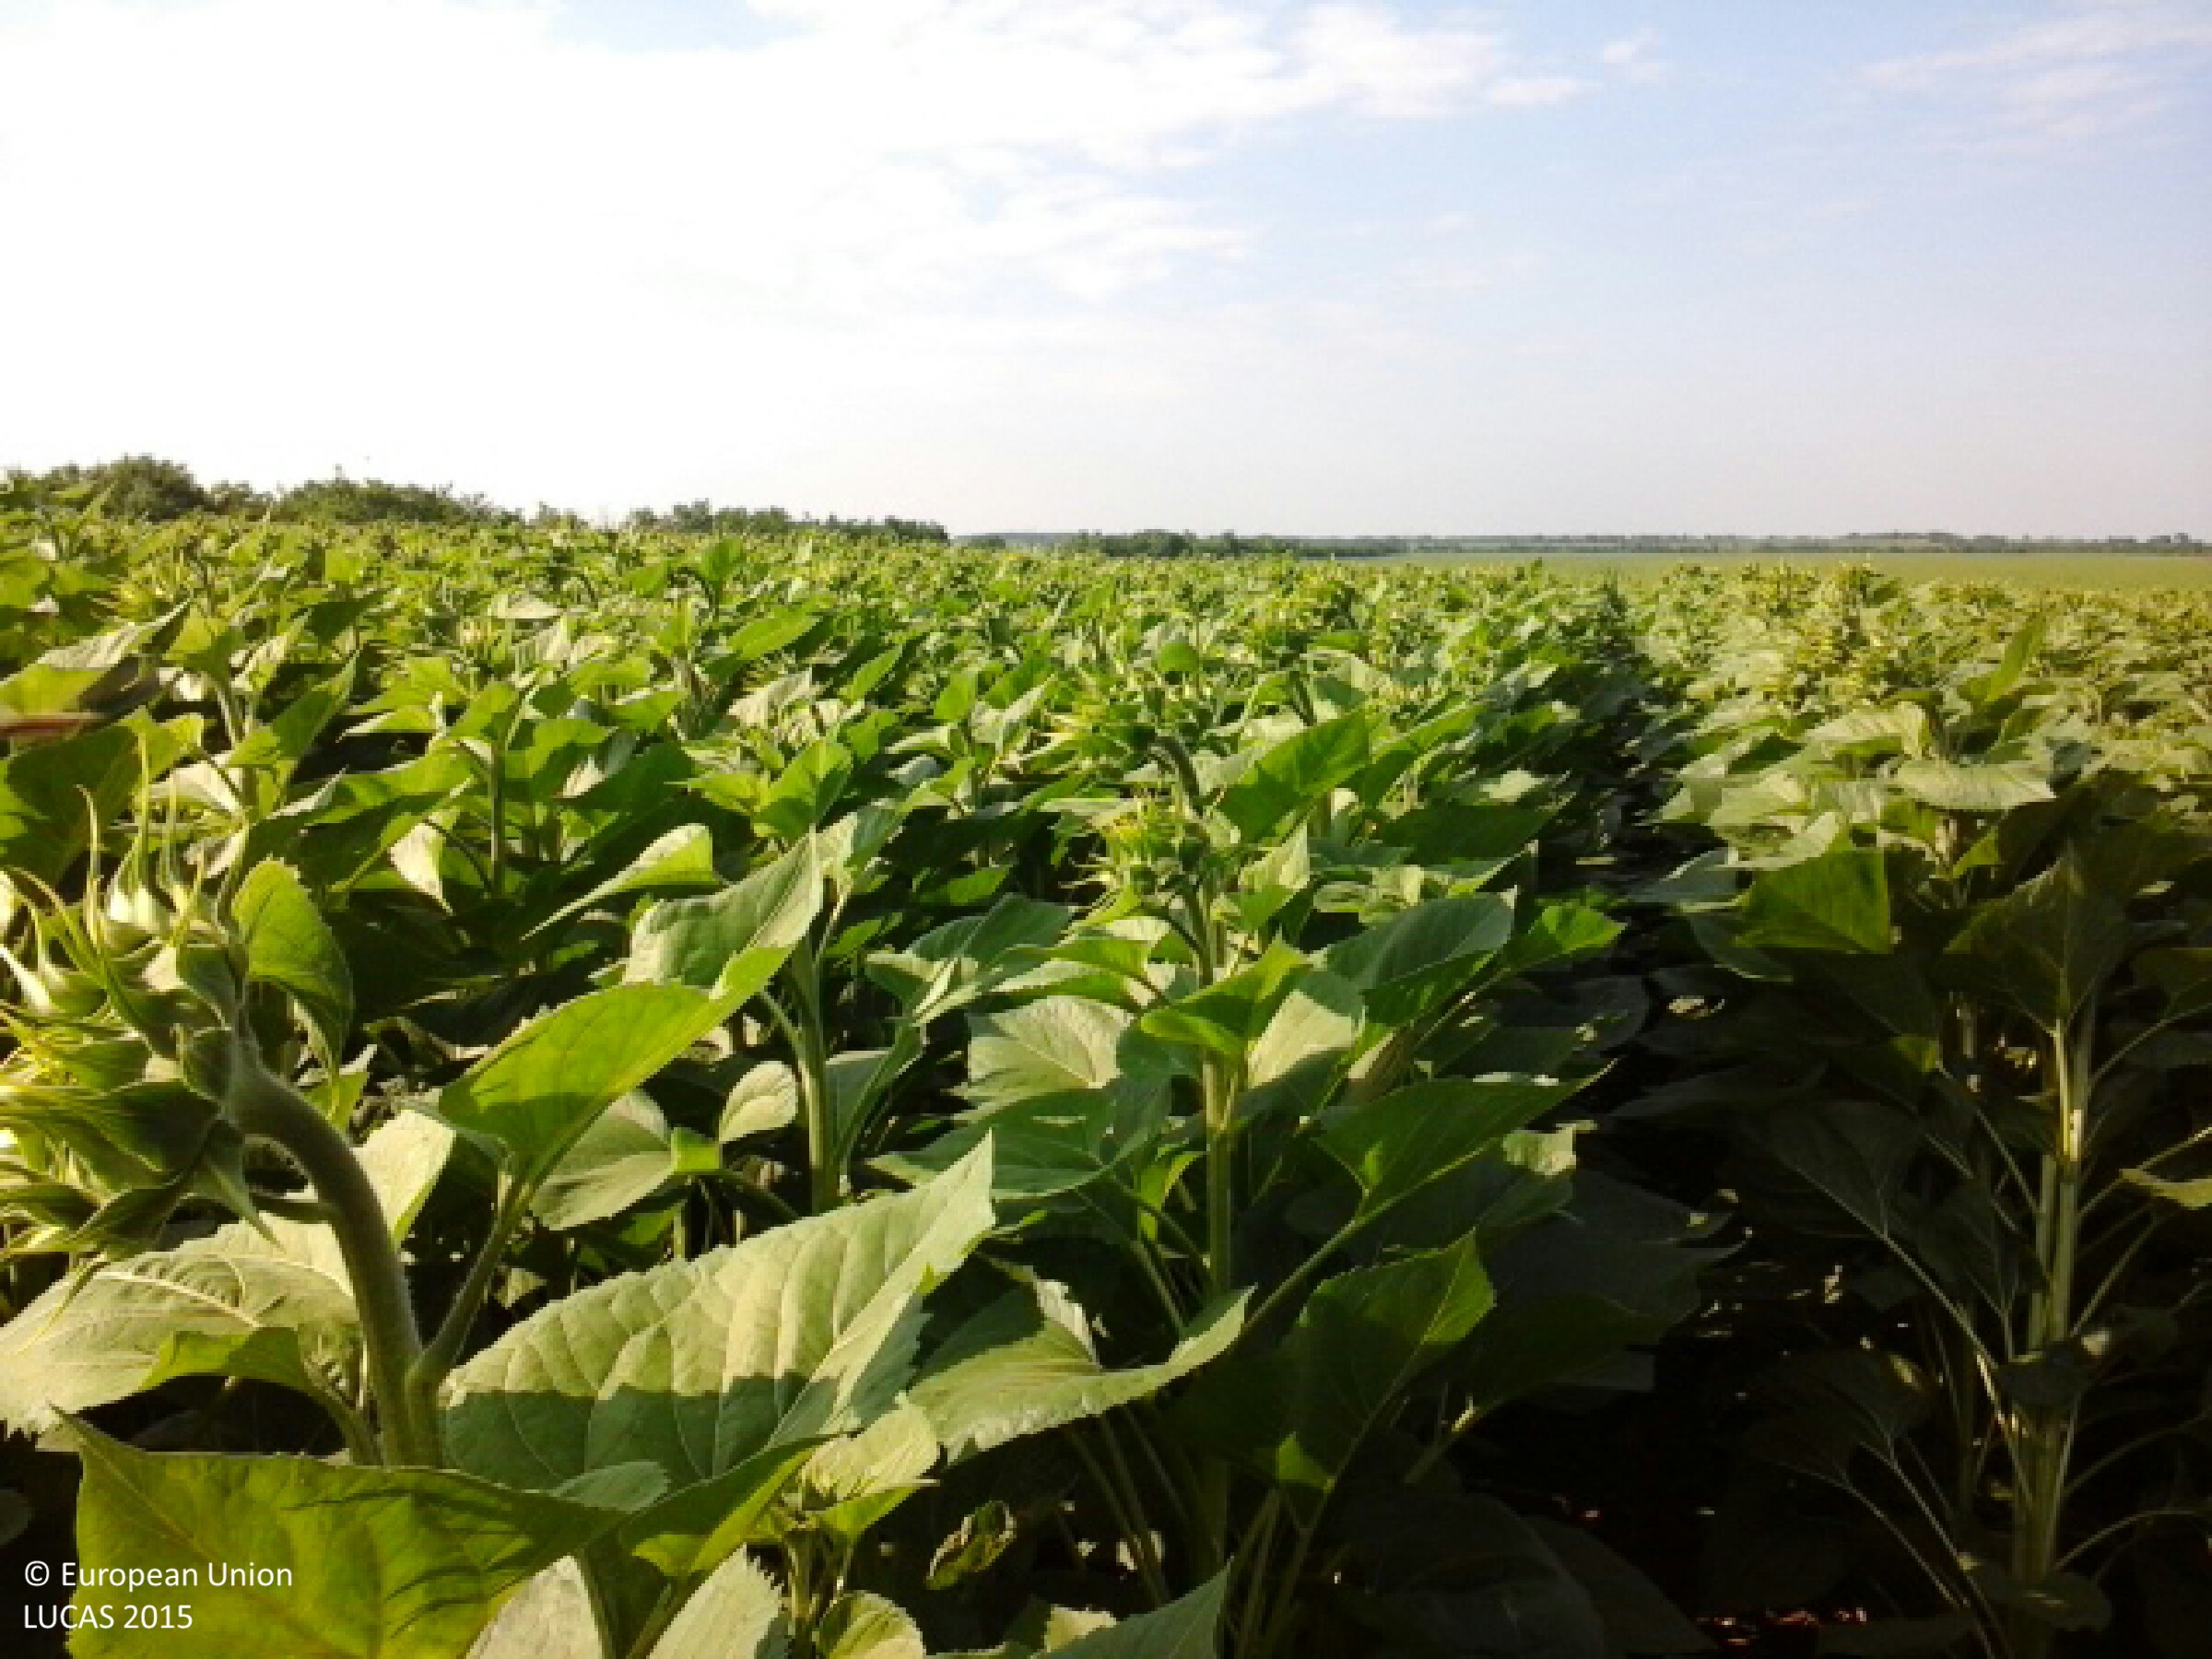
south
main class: Cropland
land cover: Sunflower
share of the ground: > 75 %
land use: Agriculture (excluding fallow land and kitchen gardens)
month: June
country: HU
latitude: 48.0334
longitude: 21.5392
